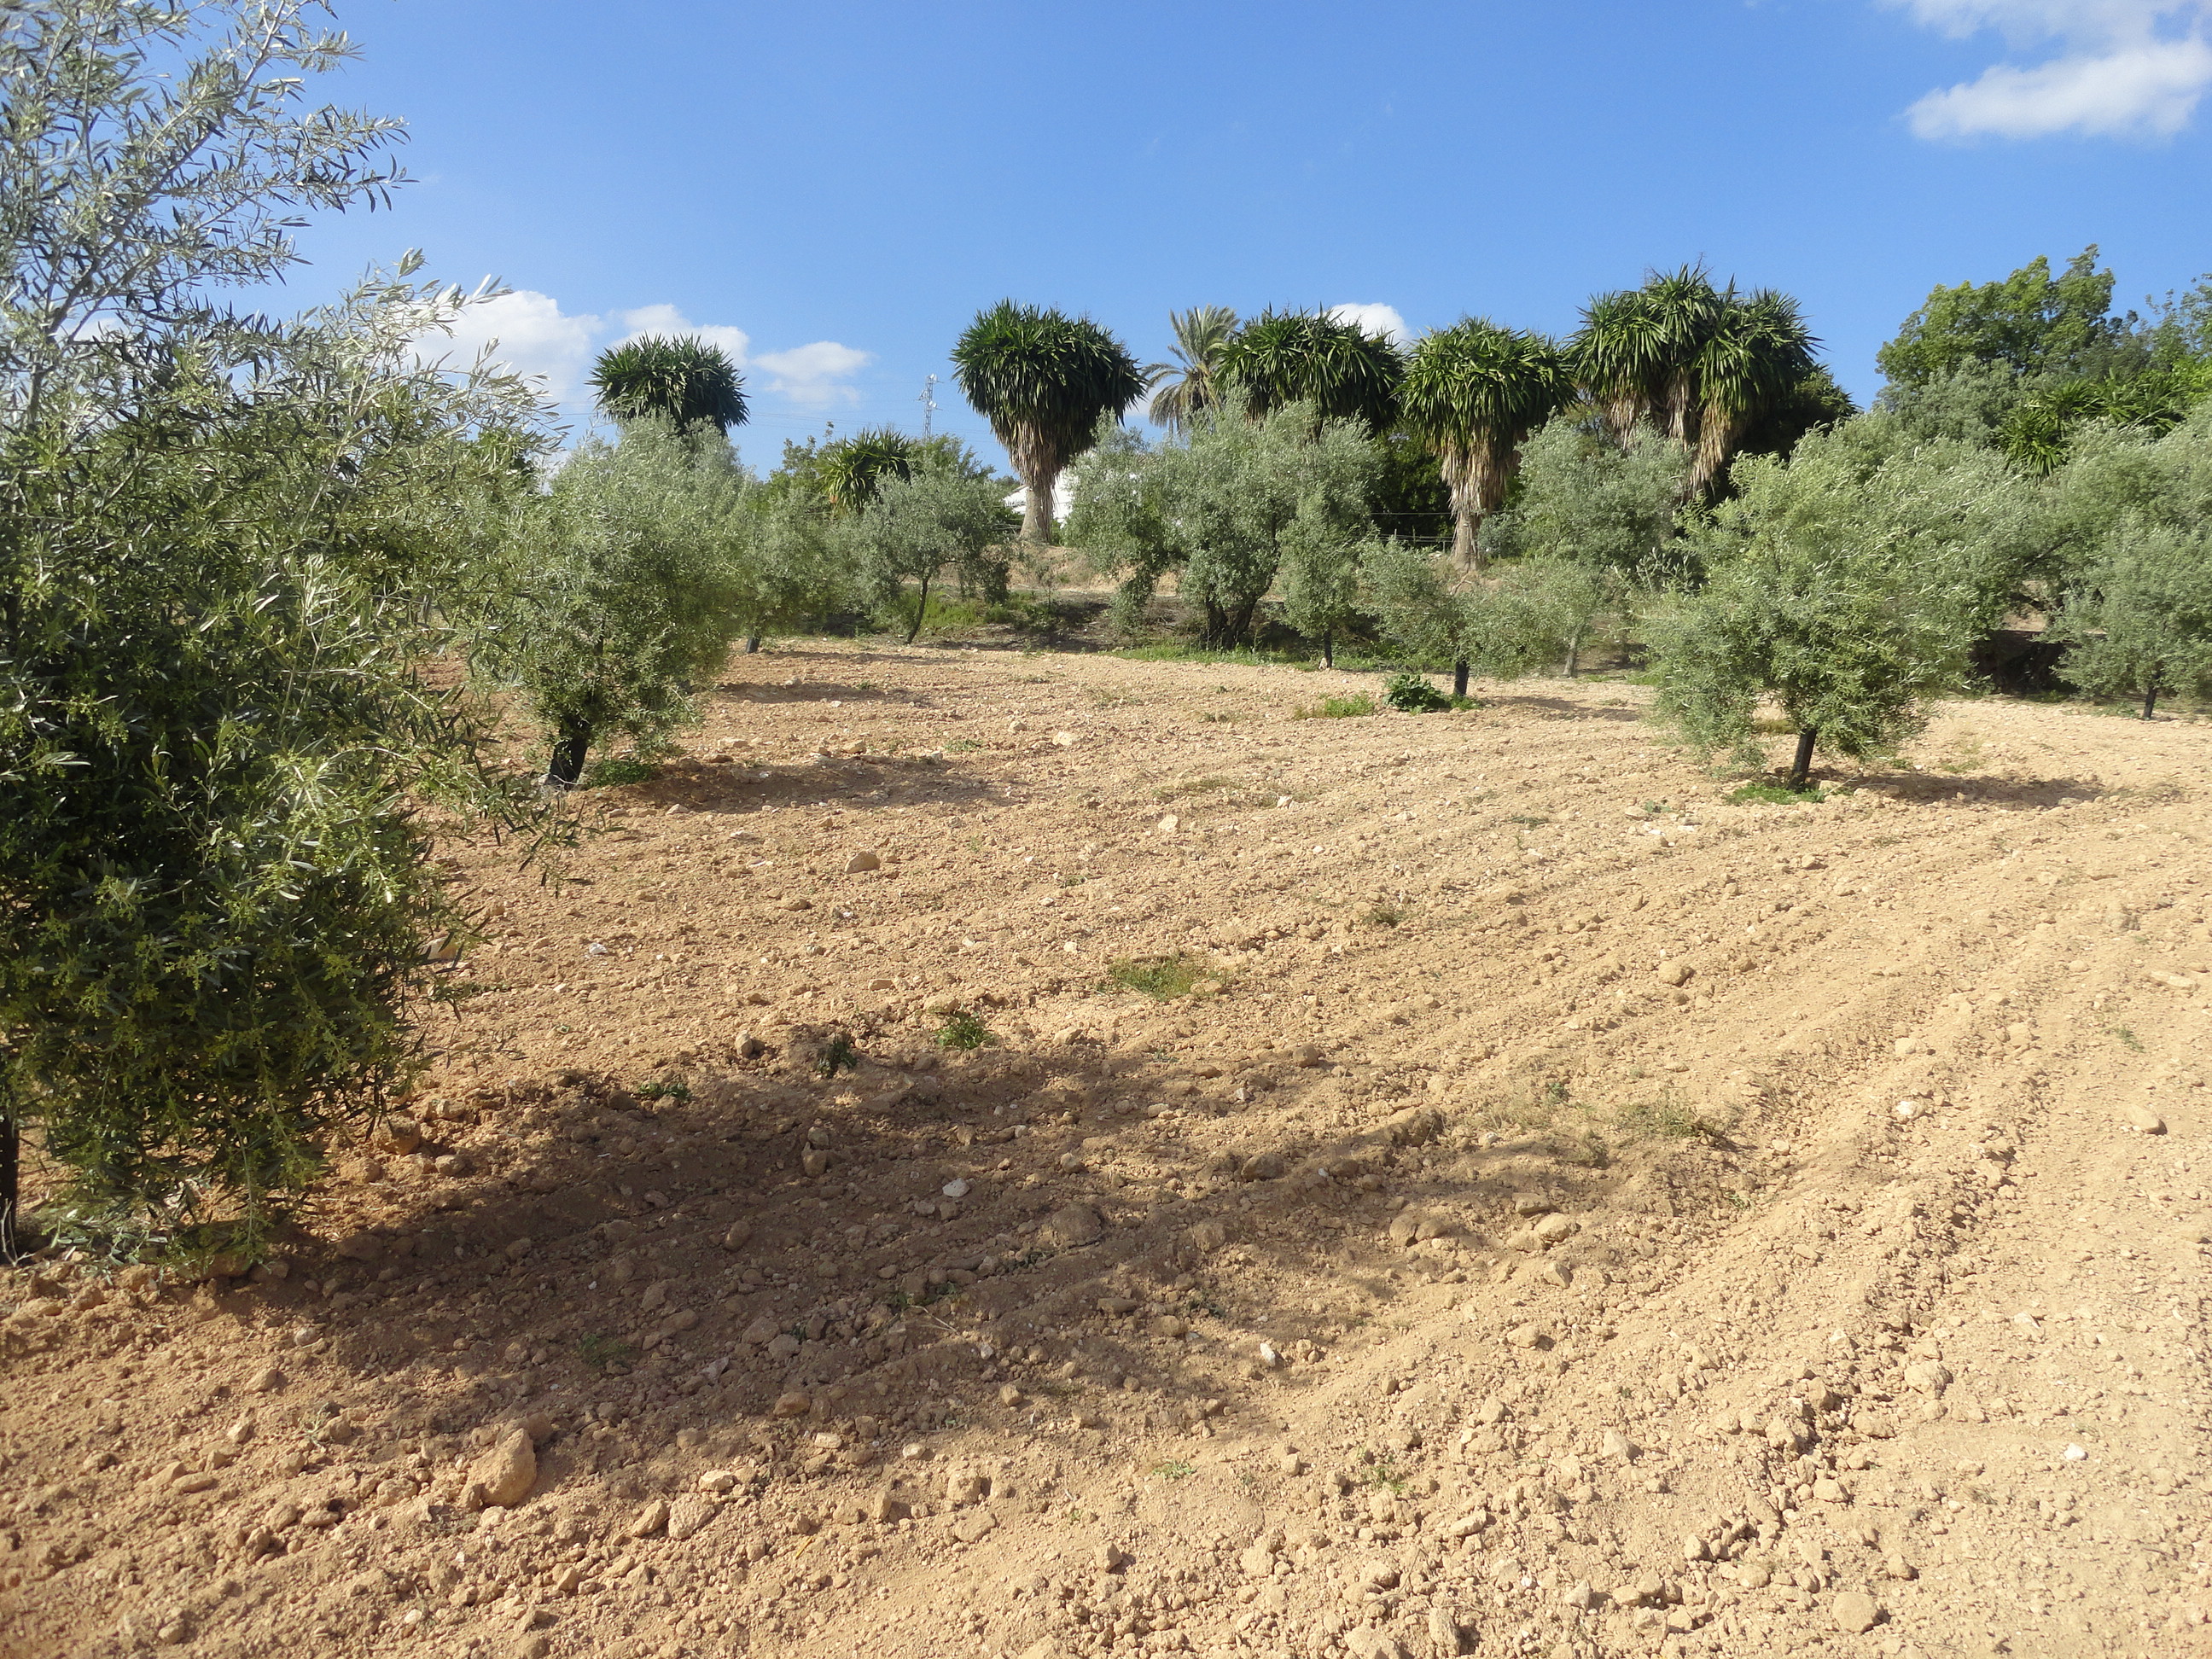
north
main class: Cropland
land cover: Olive groves
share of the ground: 10 - 25 %
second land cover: Other bare soil
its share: > 75 %
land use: Agriculture (excluding fallow land and kitchen gardens)
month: April
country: ES
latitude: 37.5272
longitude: -4.5230
